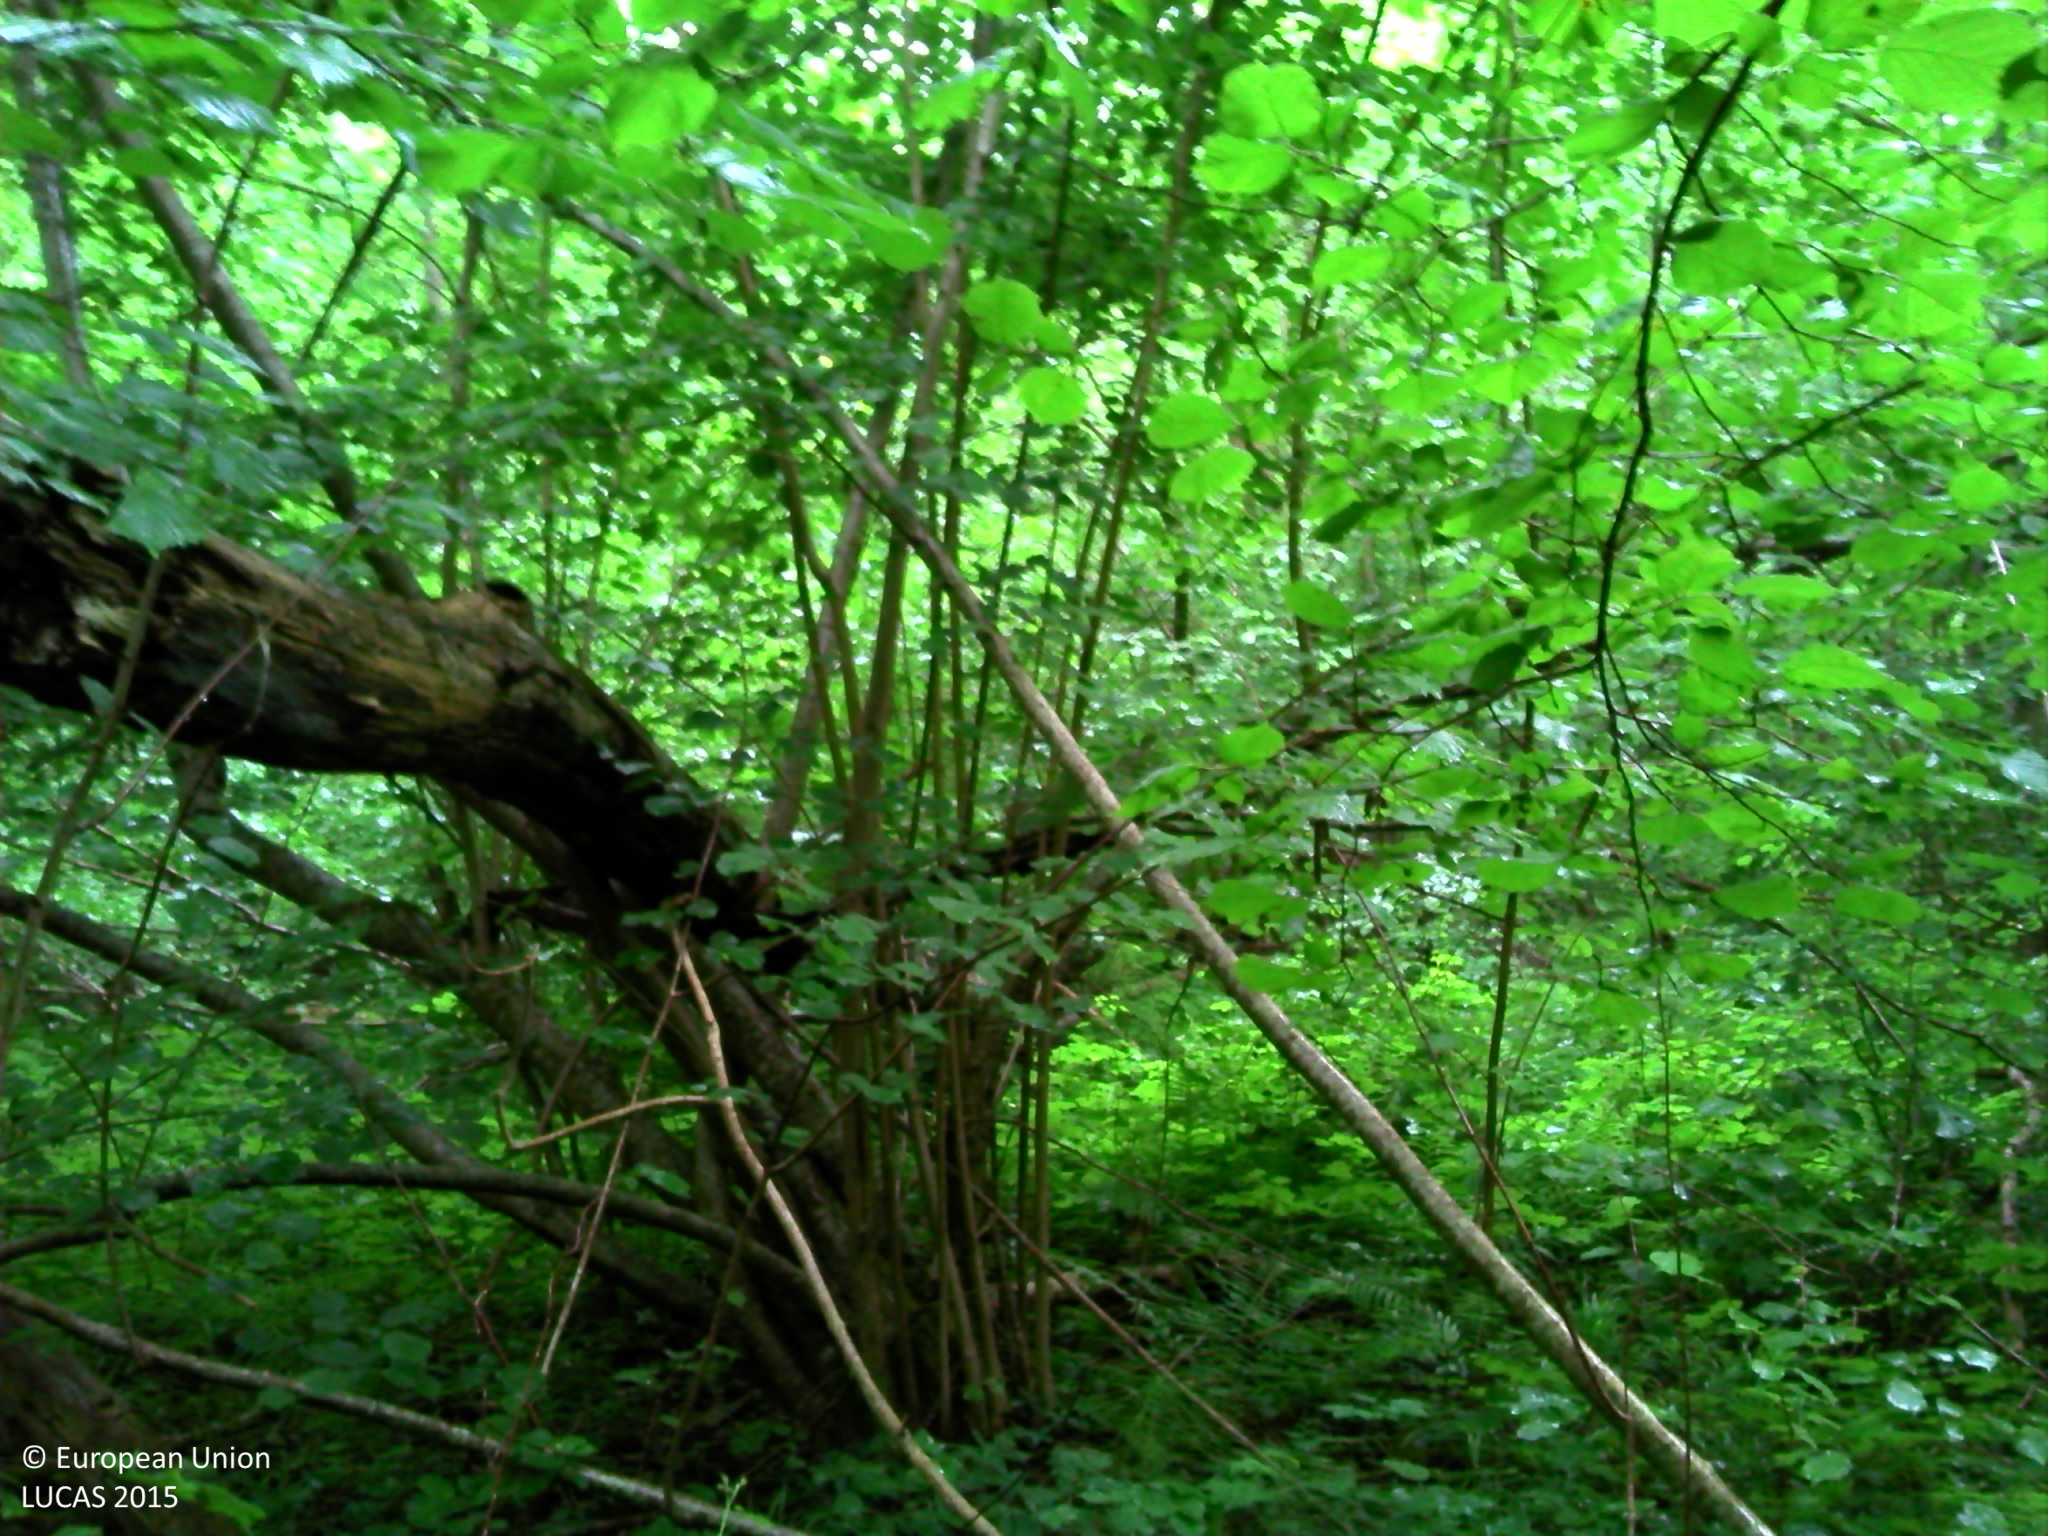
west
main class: Woodland
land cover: Broadleaved woodland
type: acidophilous oak and oak-birch forest
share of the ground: > 75 %
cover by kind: broadleaved forest trees 90 %, shrubs 5 %, herbaceous plants 5 %
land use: Forestry
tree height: > 5 m
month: June
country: FR
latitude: 49.3276
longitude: 2.8488
